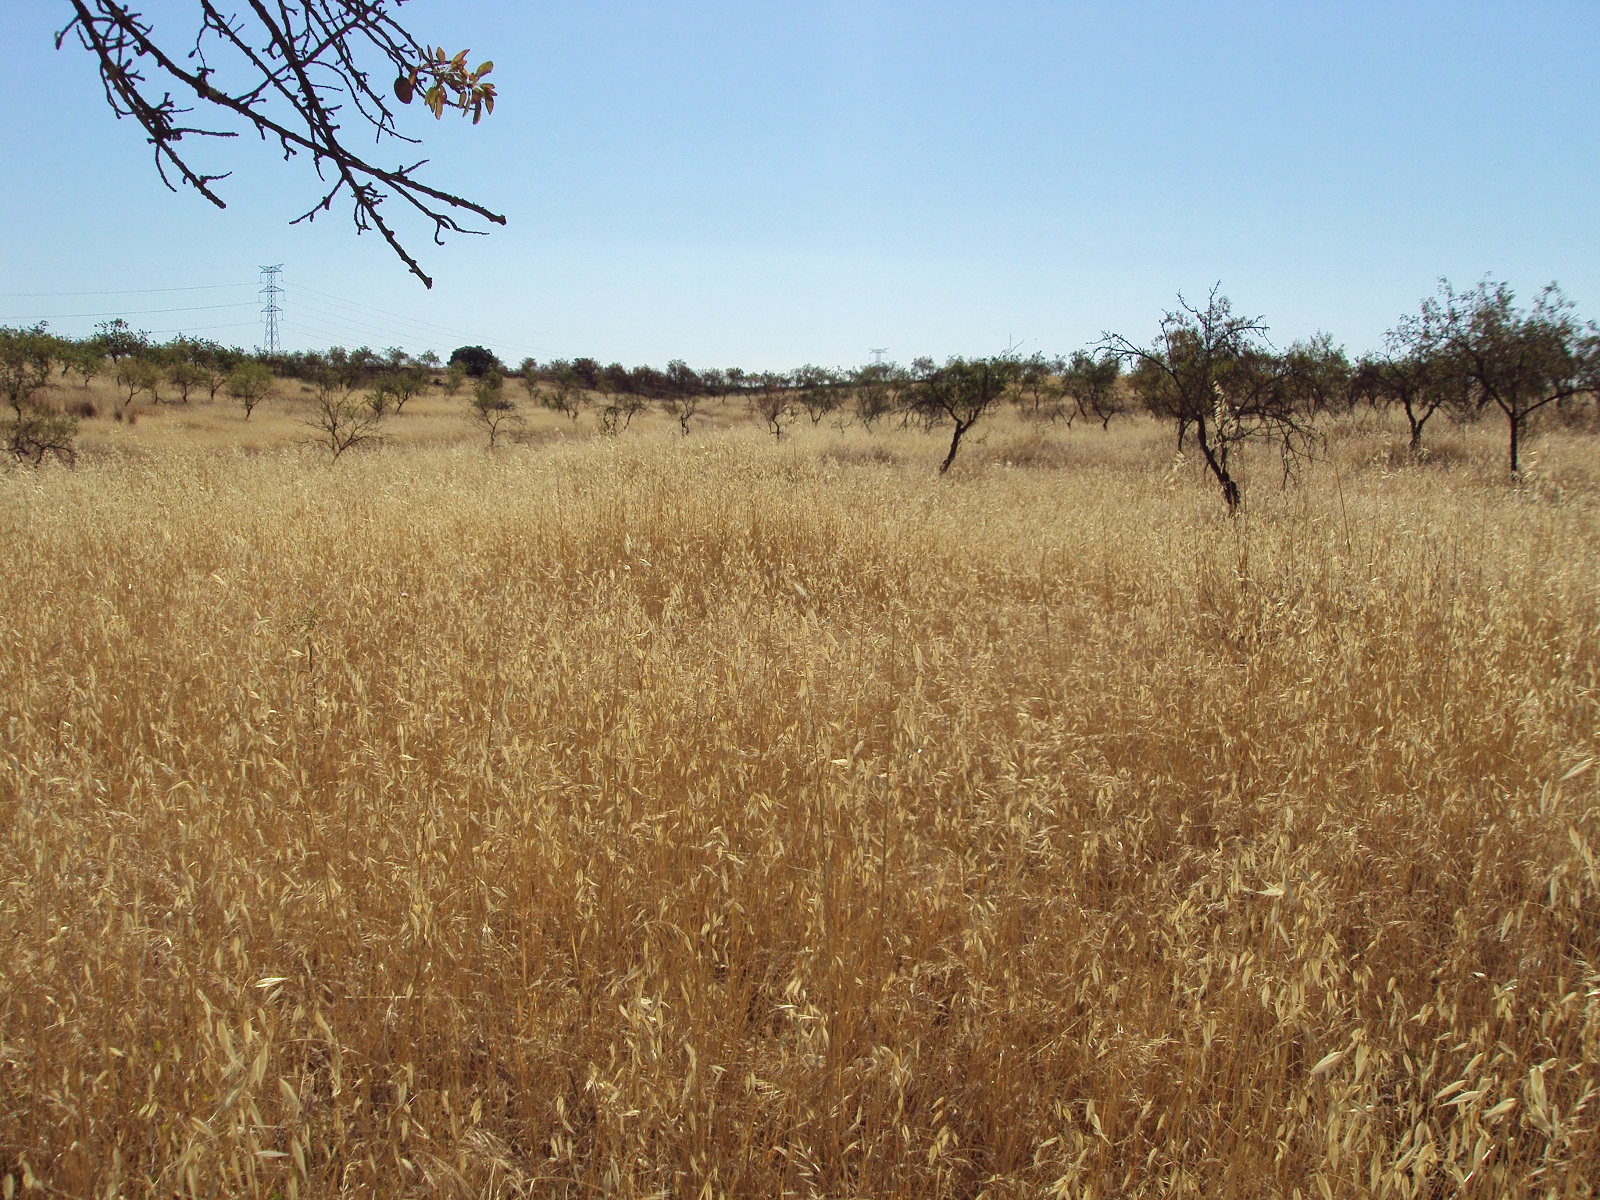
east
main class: Cropland
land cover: Nuts trees
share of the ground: 25 - 50 %
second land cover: Spontaneously vegetated surfaces
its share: > 75 %
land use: Agriculture (excluding fallow land and kitchen gardens)
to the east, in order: Nuts trees; Spontaneously vegetated surfaces; Tracks; Nuts trees
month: June
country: ES
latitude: 37.4000
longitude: -6.9290
